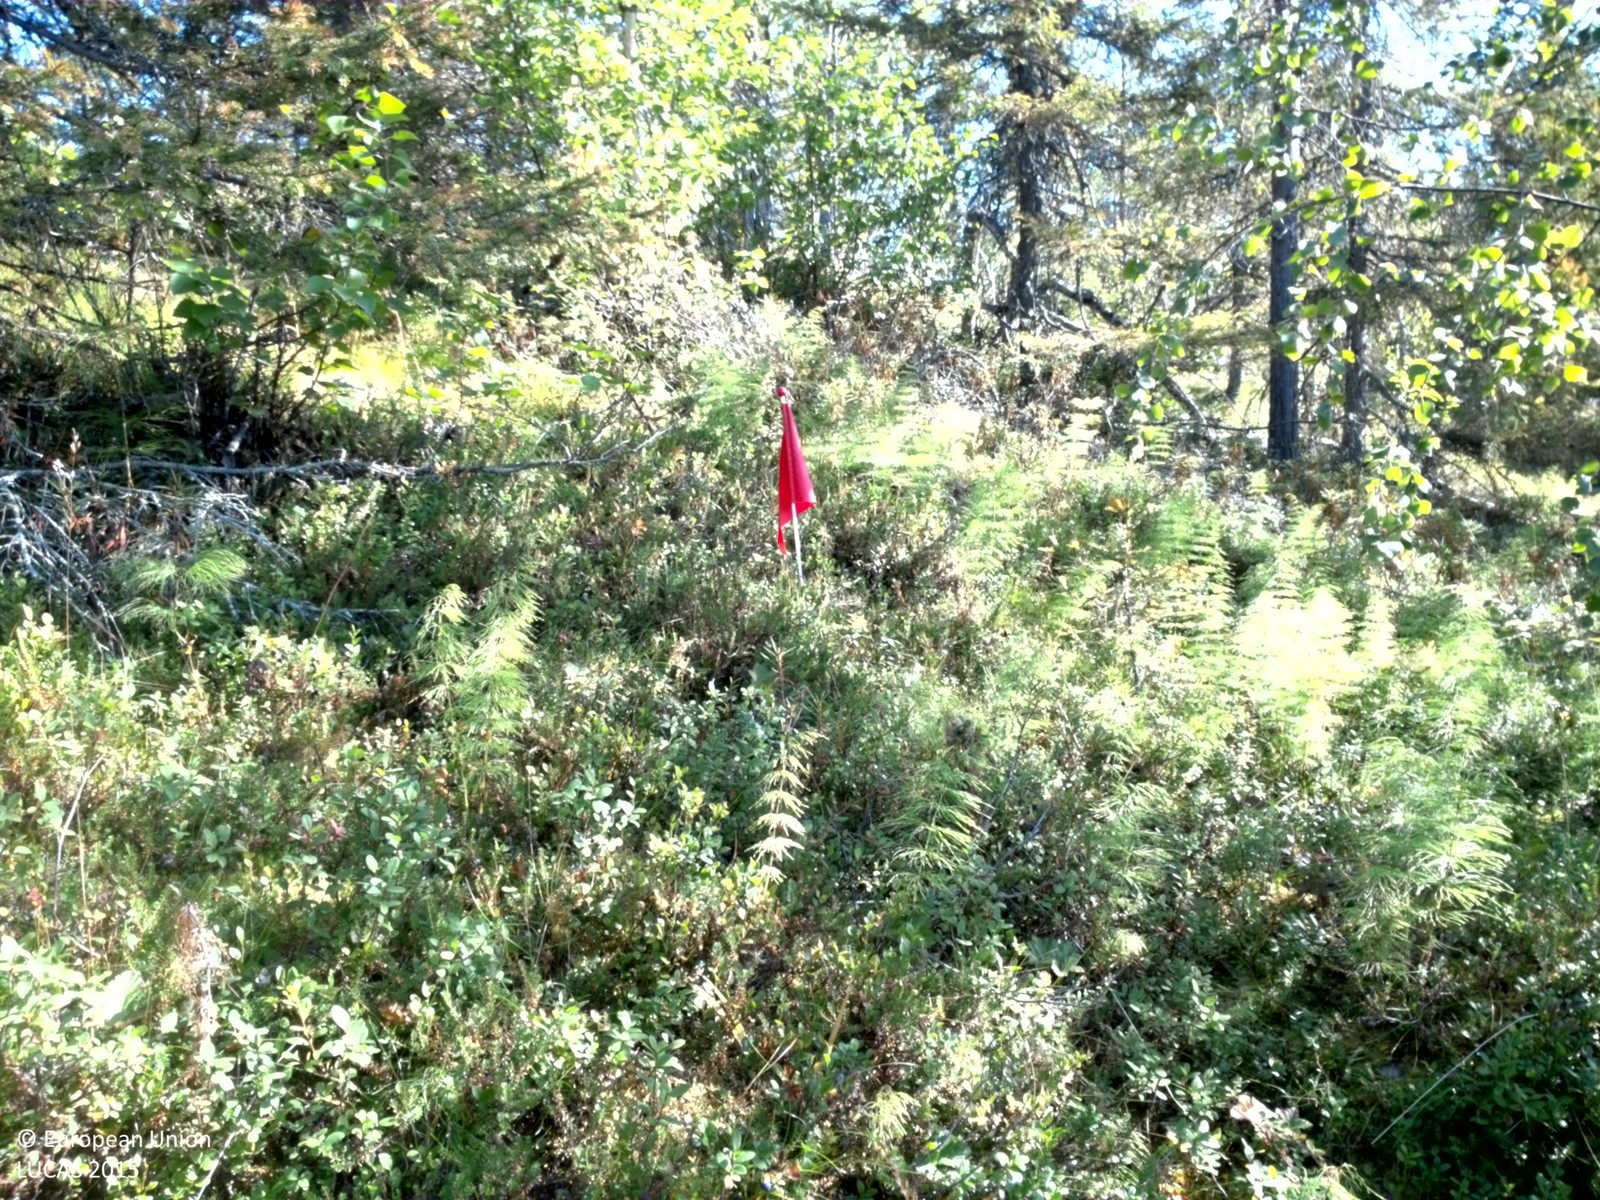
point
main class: Woodland
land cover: Spruce dominated mixed woodland
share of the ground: 25 - 50 %
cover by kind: shrubs 60 %, coniferous forest trees 20 %, broadleaved forest trees 10 %, lichens and mosses 10 %
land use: Forestry
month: August
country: SE
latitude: 66.6949
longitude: 20.8510
